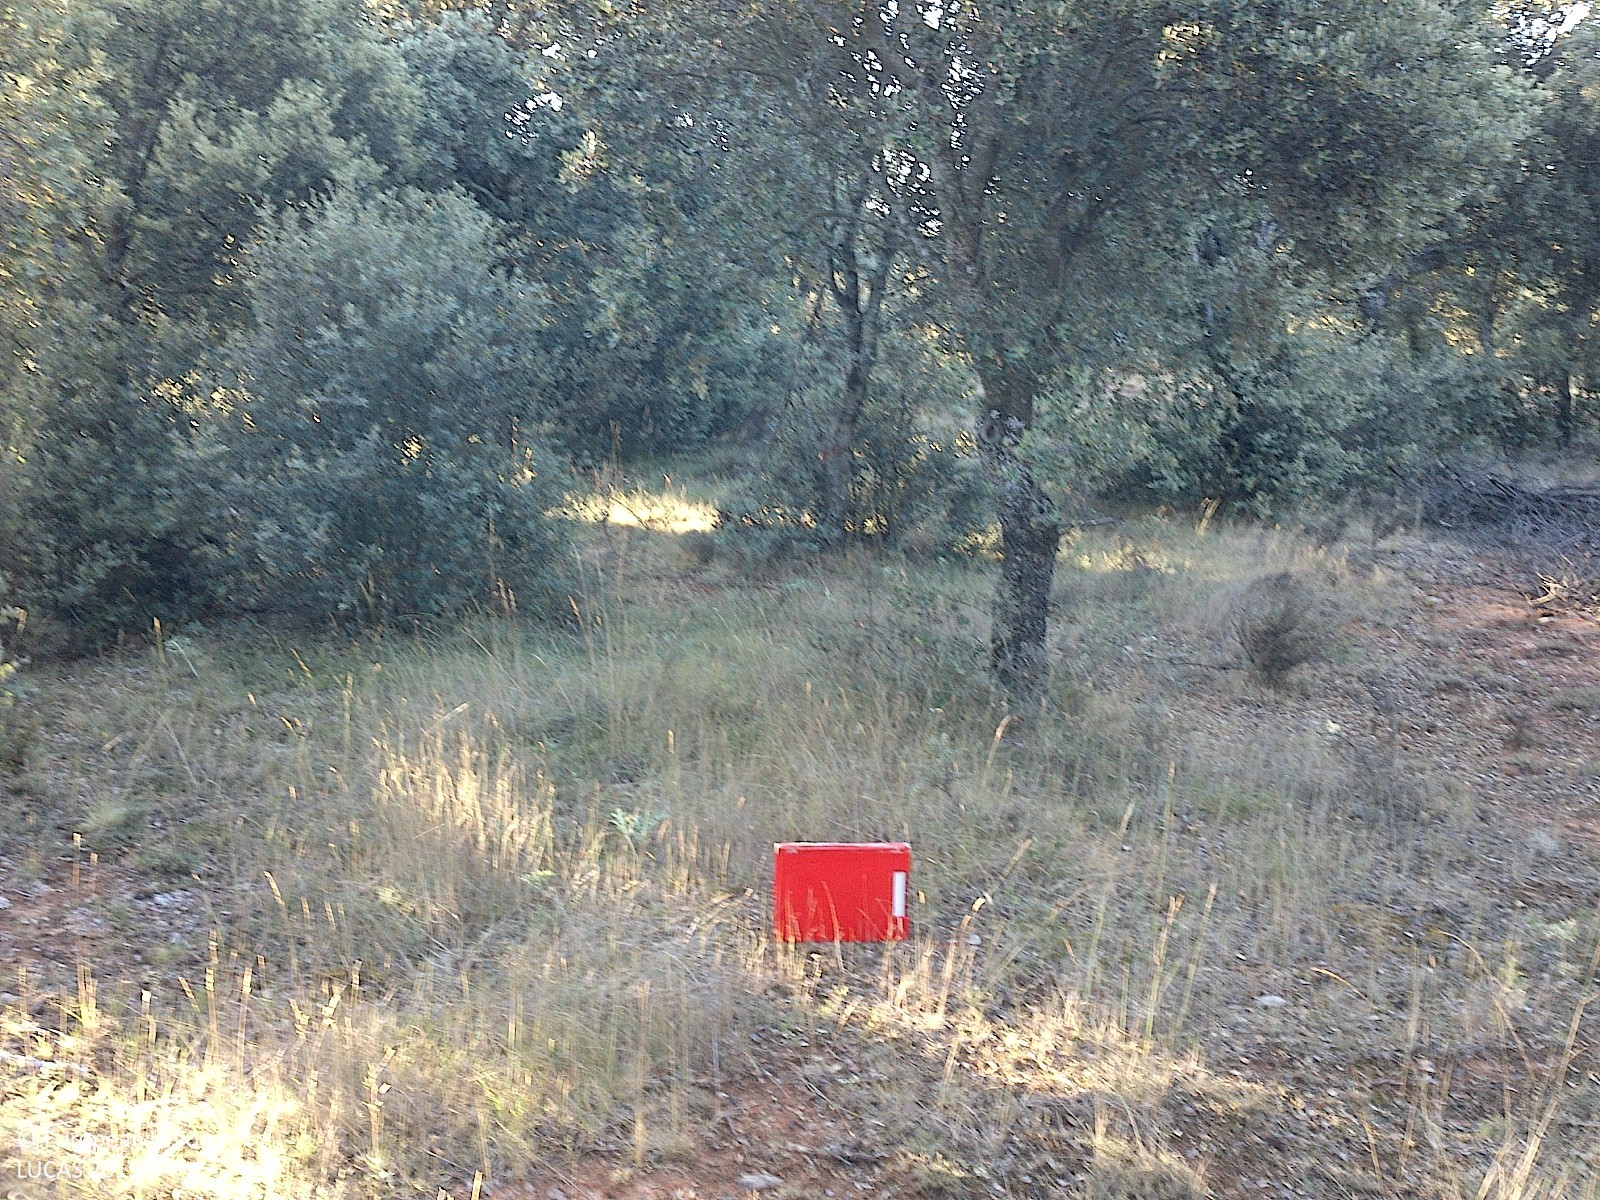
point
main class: Woodland
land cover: Broadleaved woodland
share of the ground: > 75 %
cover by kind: broadleaved forest trees 80 %, herbaceous plants 15 %, shrubs 5 %
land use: Forestry
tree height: < 5 m
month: July
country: ES
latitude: 41.7790
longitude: -1.9555
